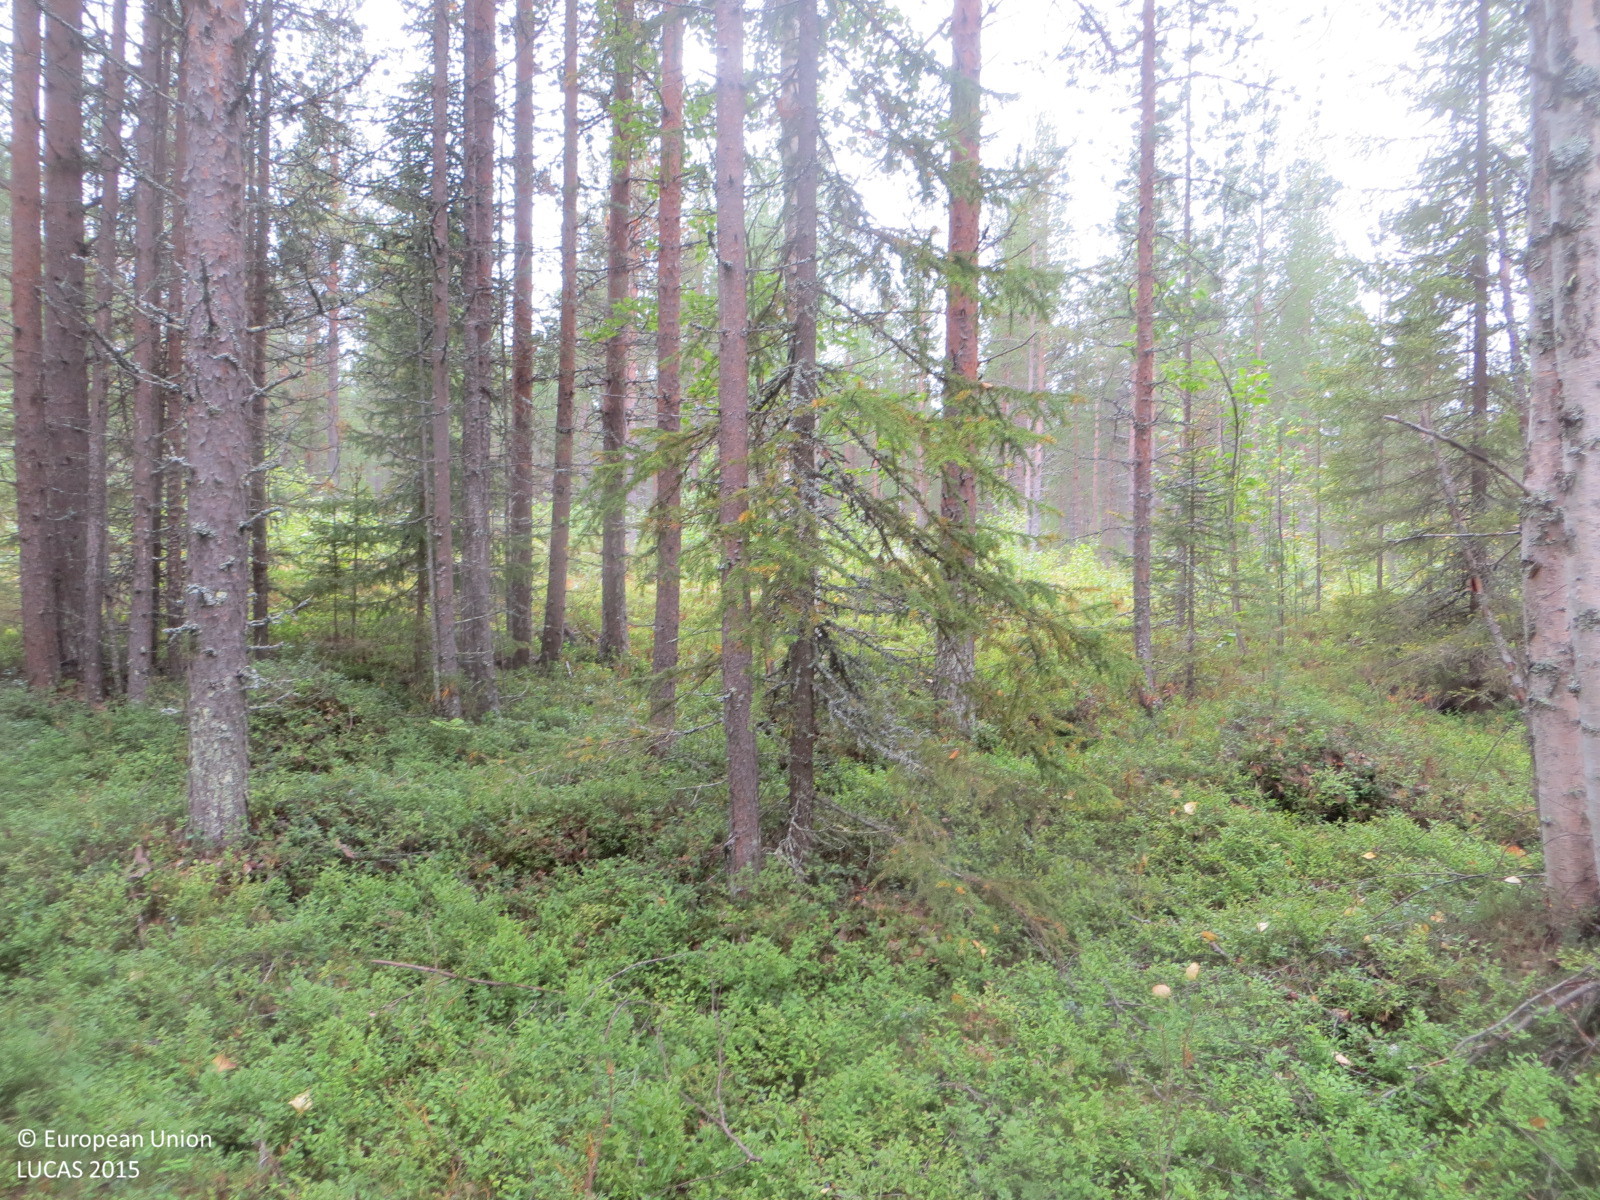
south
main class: Woodland
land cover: Pine dominated mixed woodland
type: boreal forest
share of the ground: 50 - 75 %
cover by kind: coniferous forest trees 45 %, shrubs 40 %, broadleaved forest trees 15 %
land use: Forestry
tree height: > 5 m
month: August
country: FI
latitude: 67.4198
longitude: 24.2877
